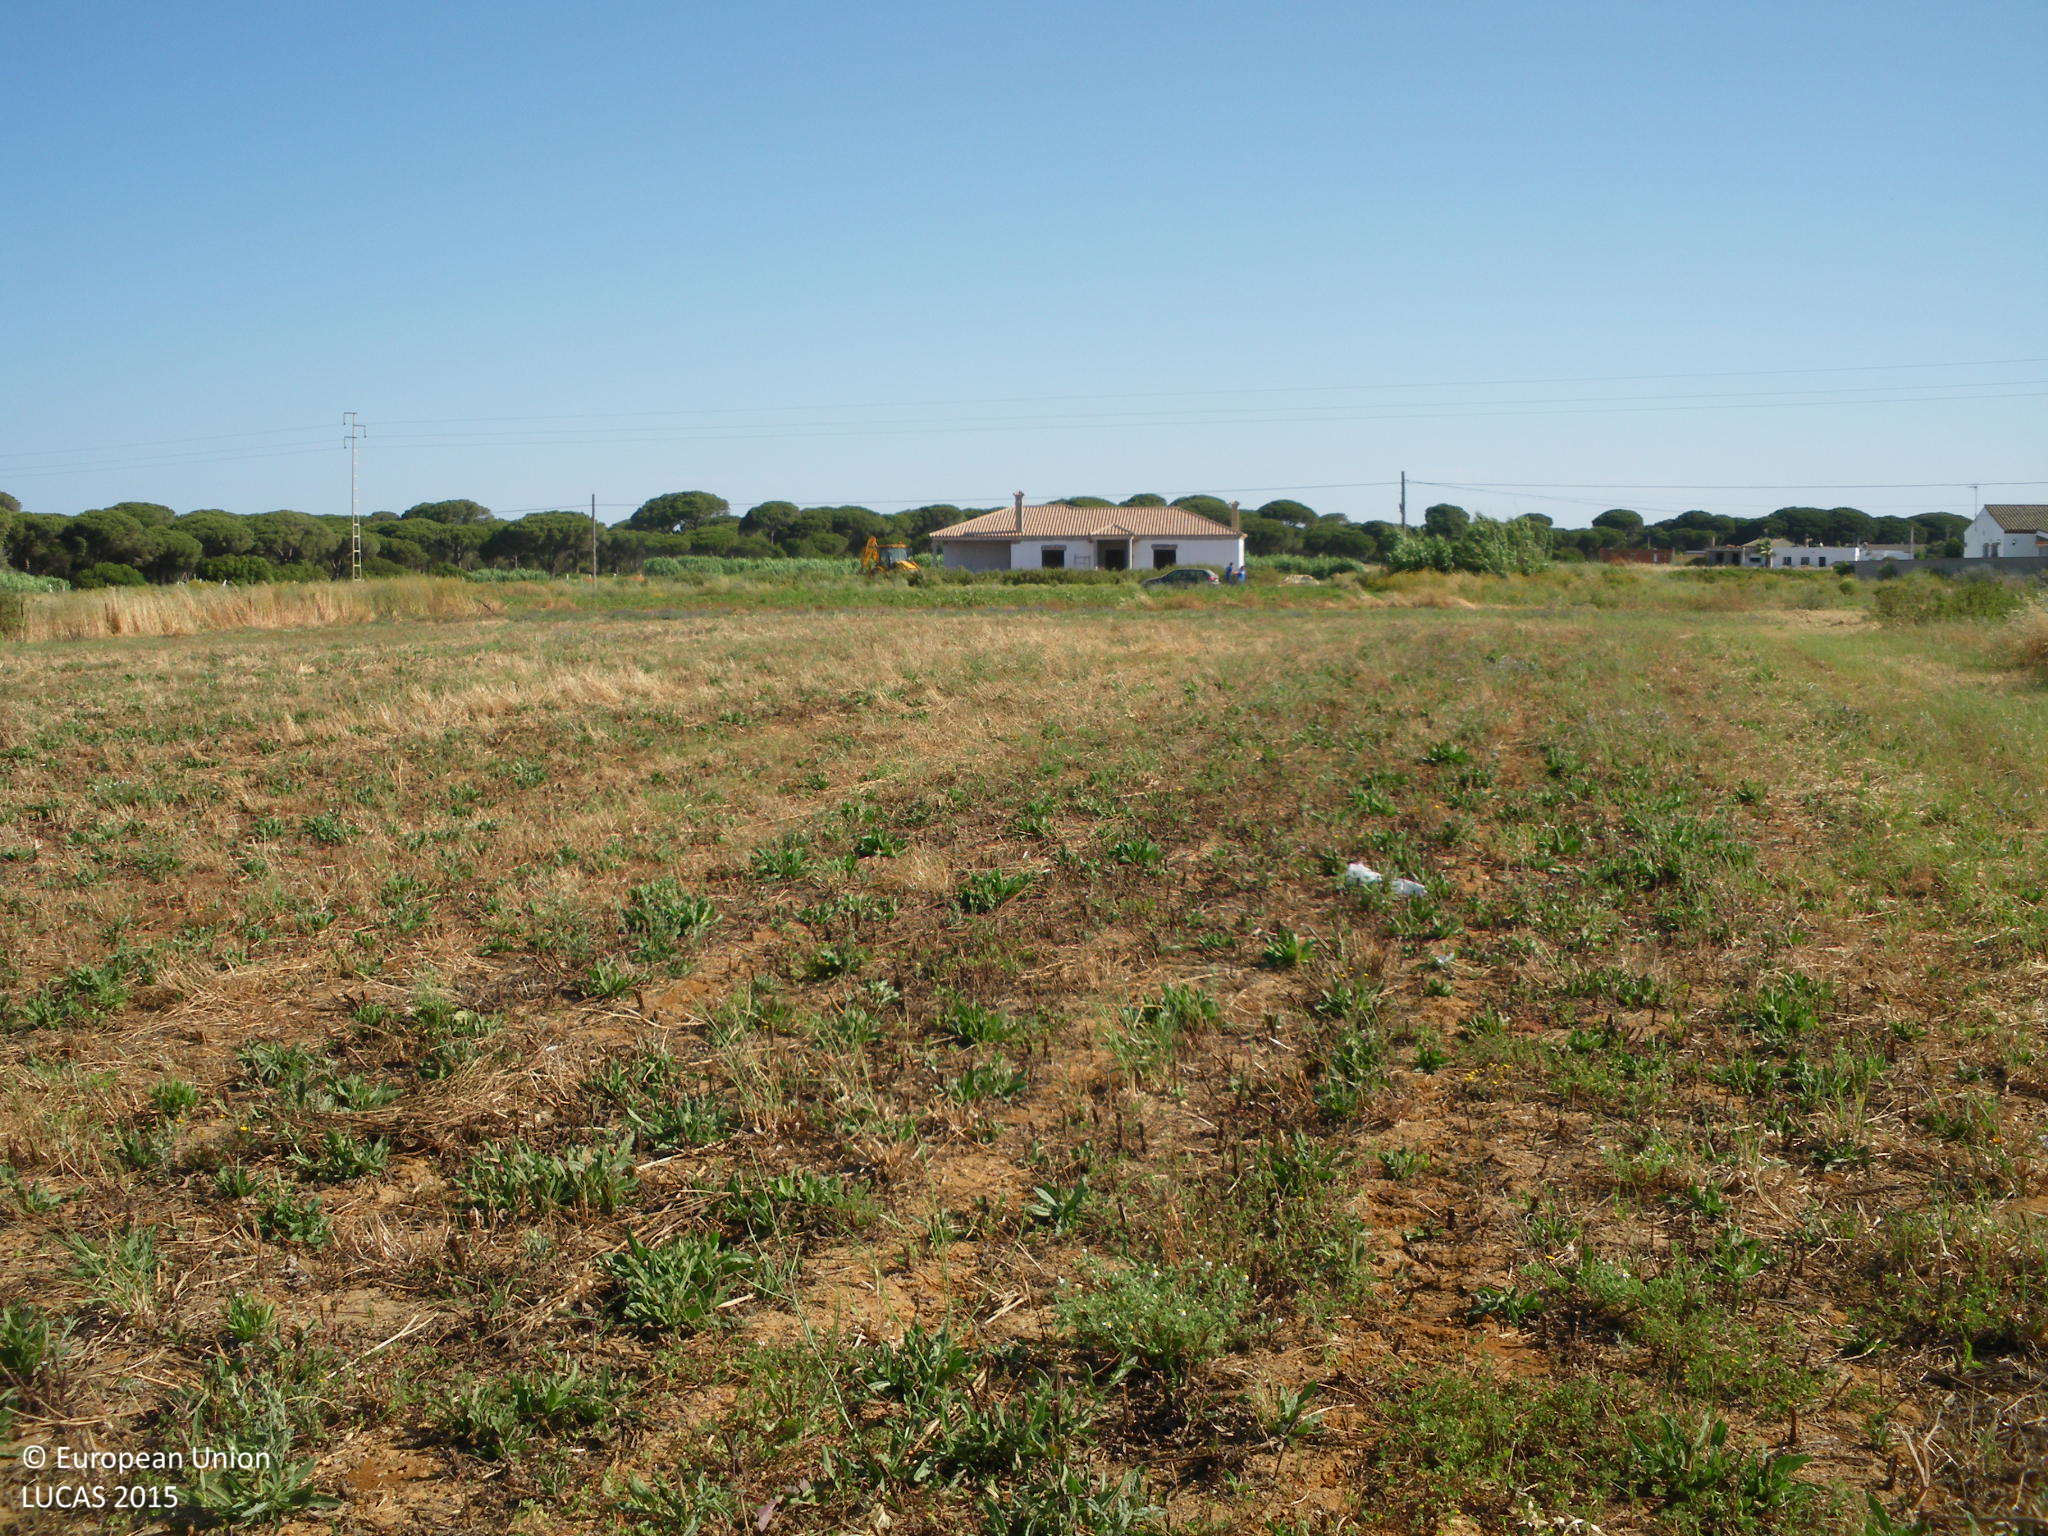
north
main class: Grassland
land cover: Spontaneously vegetated surfaces
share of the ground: > 75 %
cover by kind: herbaceous plants 85 %, unconsolidated bare surface 15 %
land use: Fallow land
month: May
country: ES
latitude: 36.3250
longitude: -6.1233
